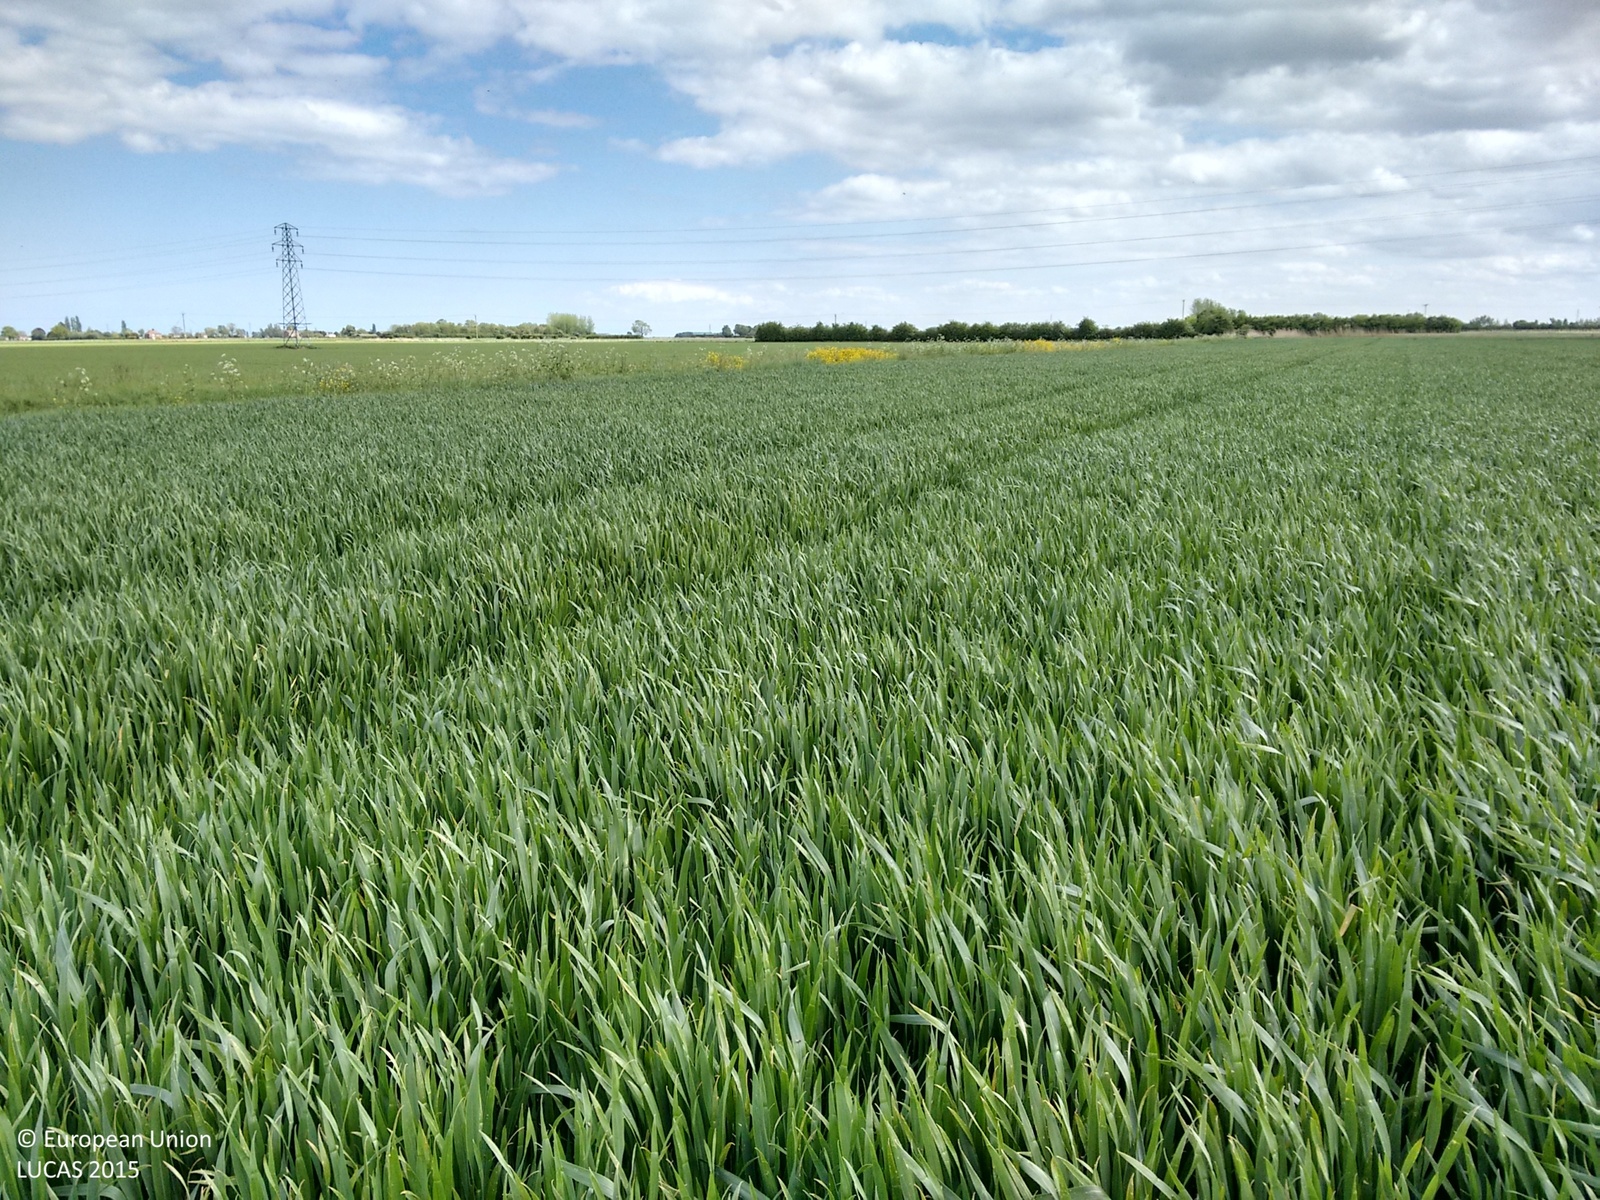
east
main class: Cropland
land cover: Common wheat
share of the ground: > 75 %
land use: Agriculture (excluding fallow land and kitchen gardens)
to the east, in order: Common wheat; Grass margins; Ditches and canals; Tracks; Grass margins; Dry pulses; Electric lines; Dry pulses
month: May
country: GB
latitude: 52.9112
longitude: -0.0402
